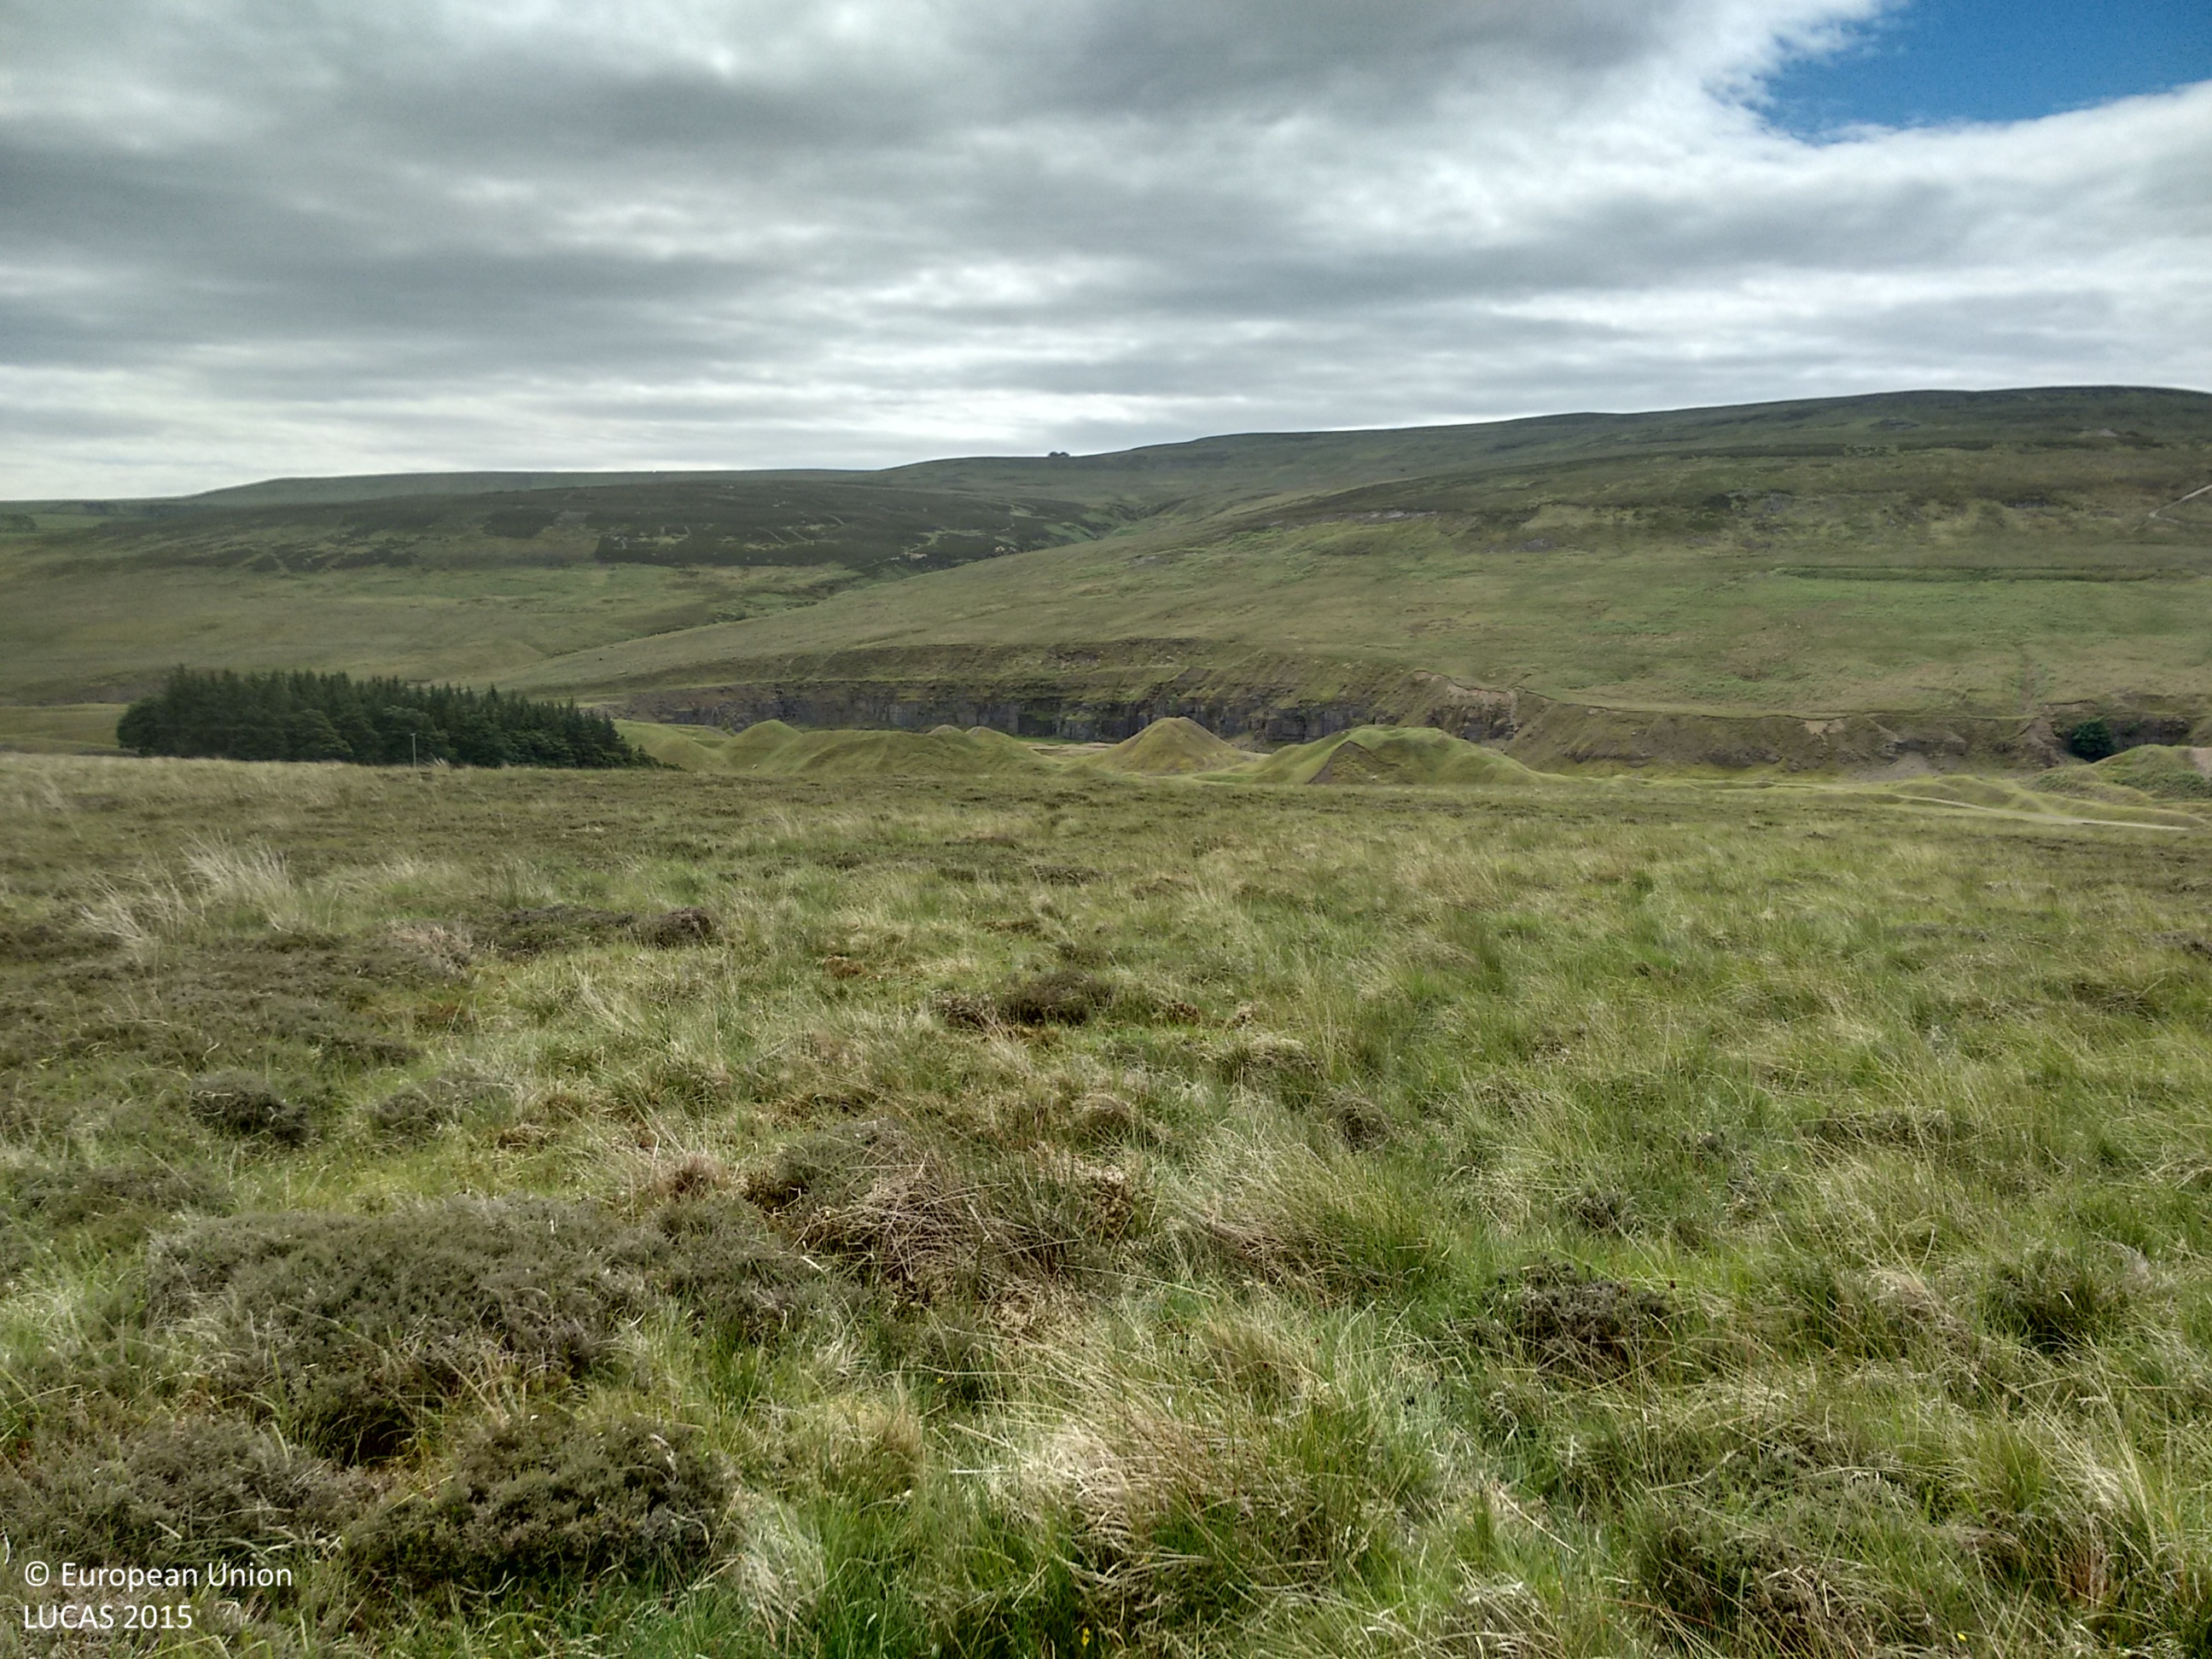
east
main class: Shrubland
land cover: Shrubland without tree cover
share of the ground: > 75 %
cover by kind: shrubs 70 %, herbaceous plants 30 %
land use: Agriculture (excluding fallow land and kitchen gardens)
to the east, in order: Shrubland without tree cover
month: June
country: GB
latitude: 54.7132
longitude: -1.9919
